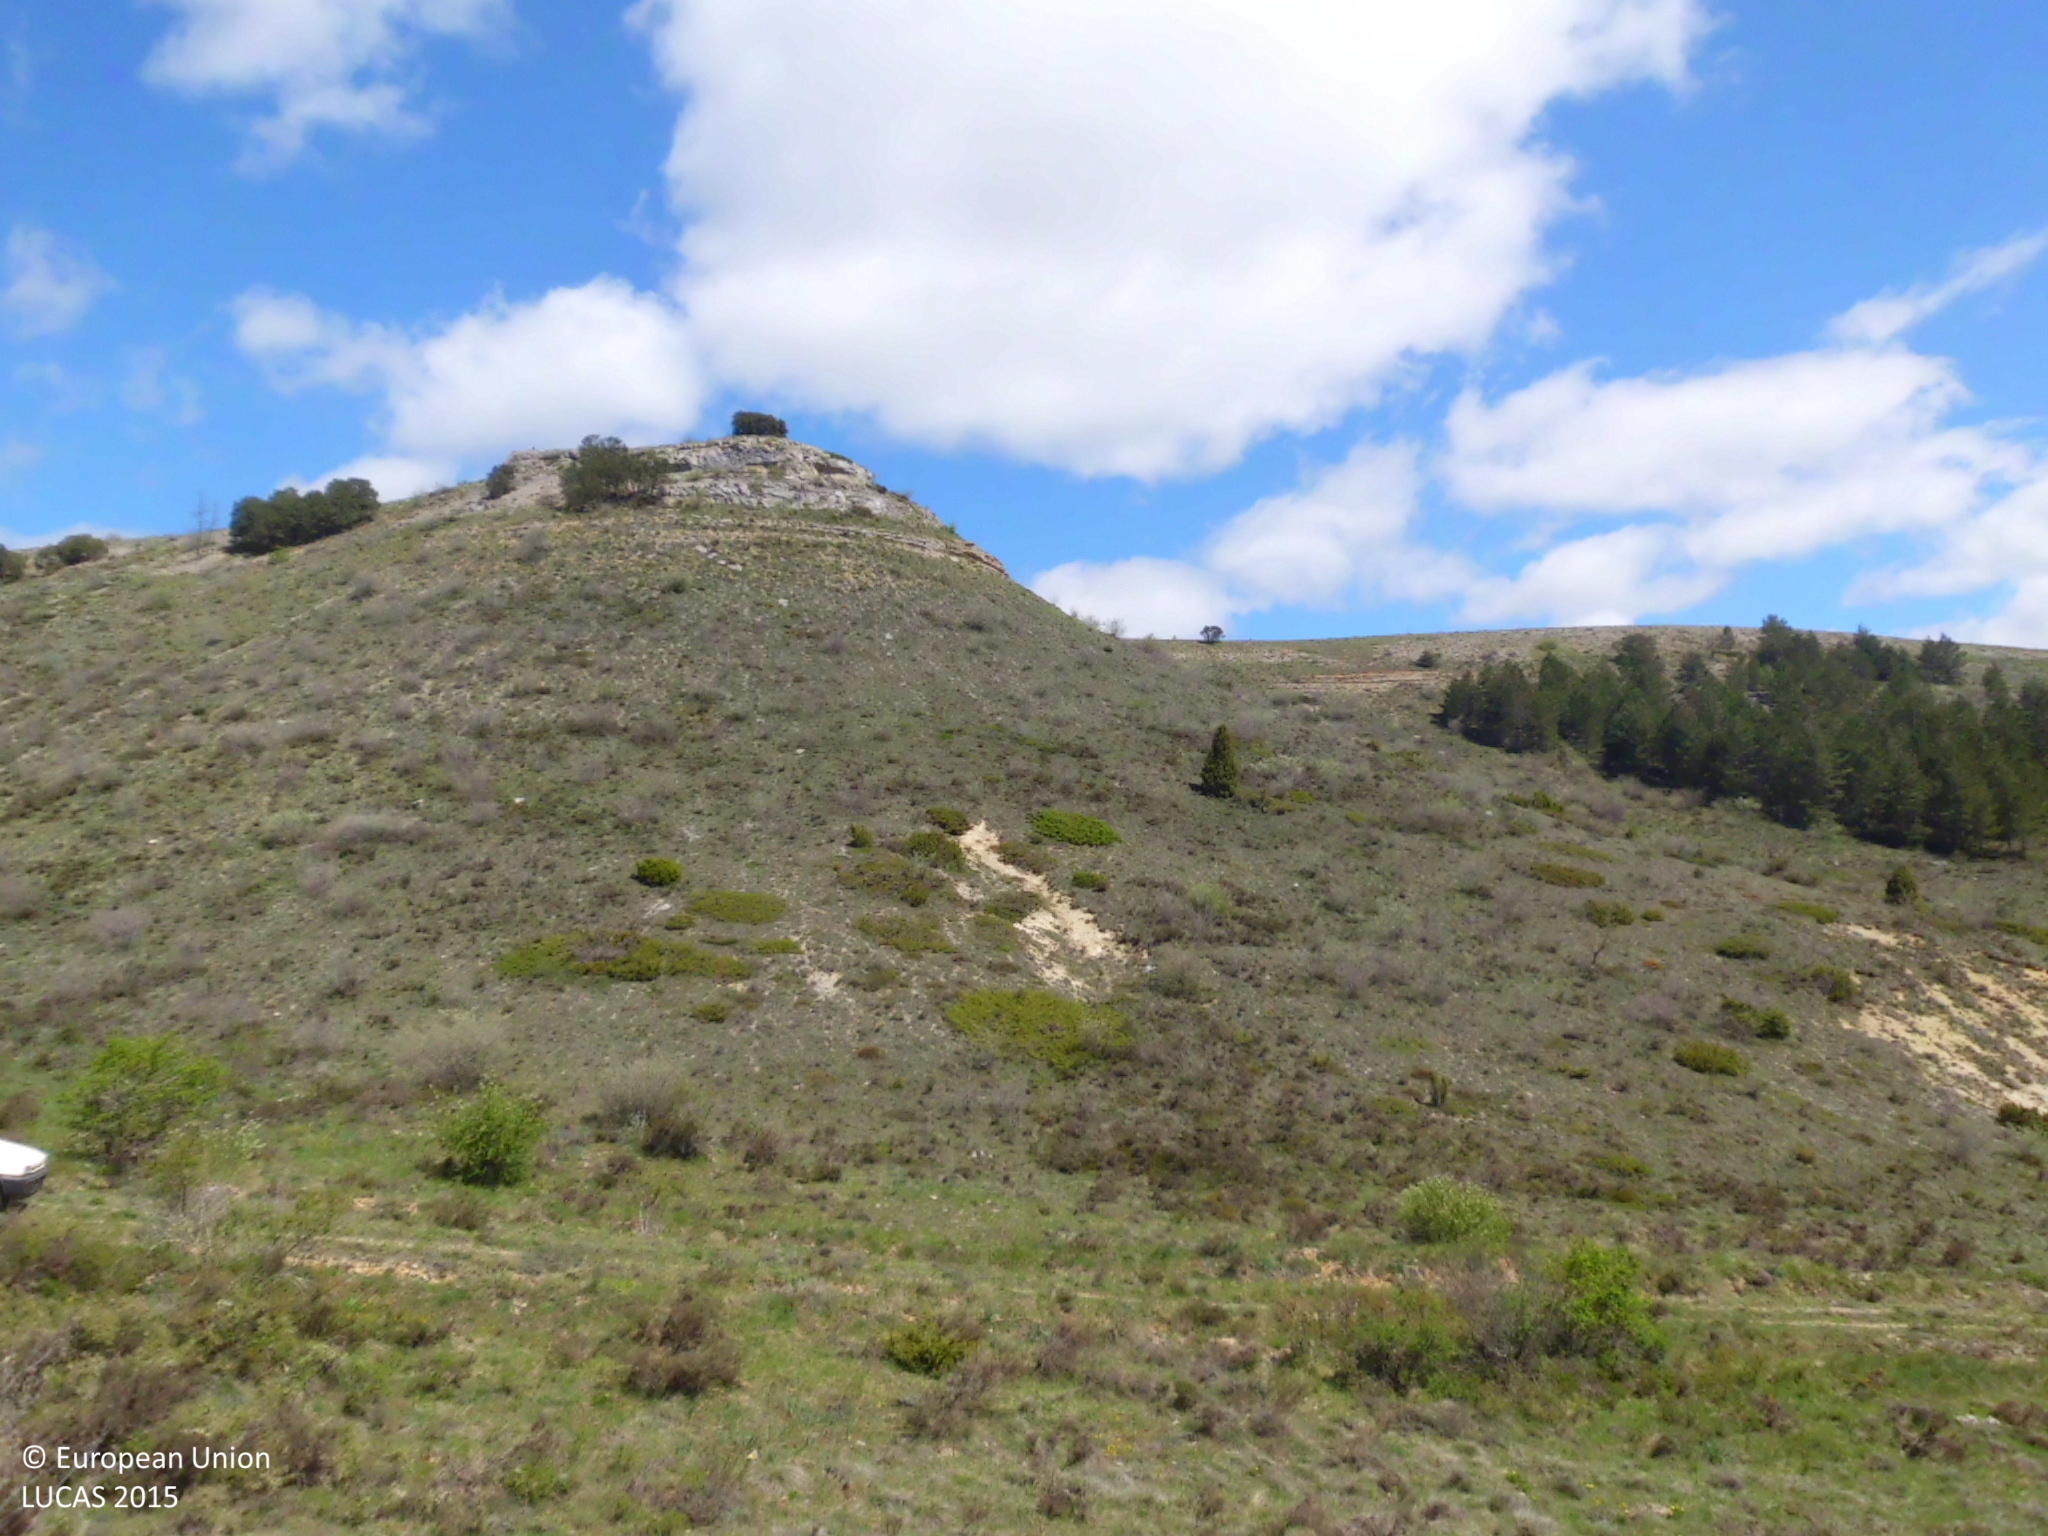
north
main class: Shrubland
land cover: Shrubland without tree cover
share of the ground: 25 - 50 %
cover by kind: herbaceous plants 60 %, shrubs 40 %
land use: Semi-natural and natural areas not in use
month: May
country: ES
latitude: 42.7522
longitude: -3.7620
